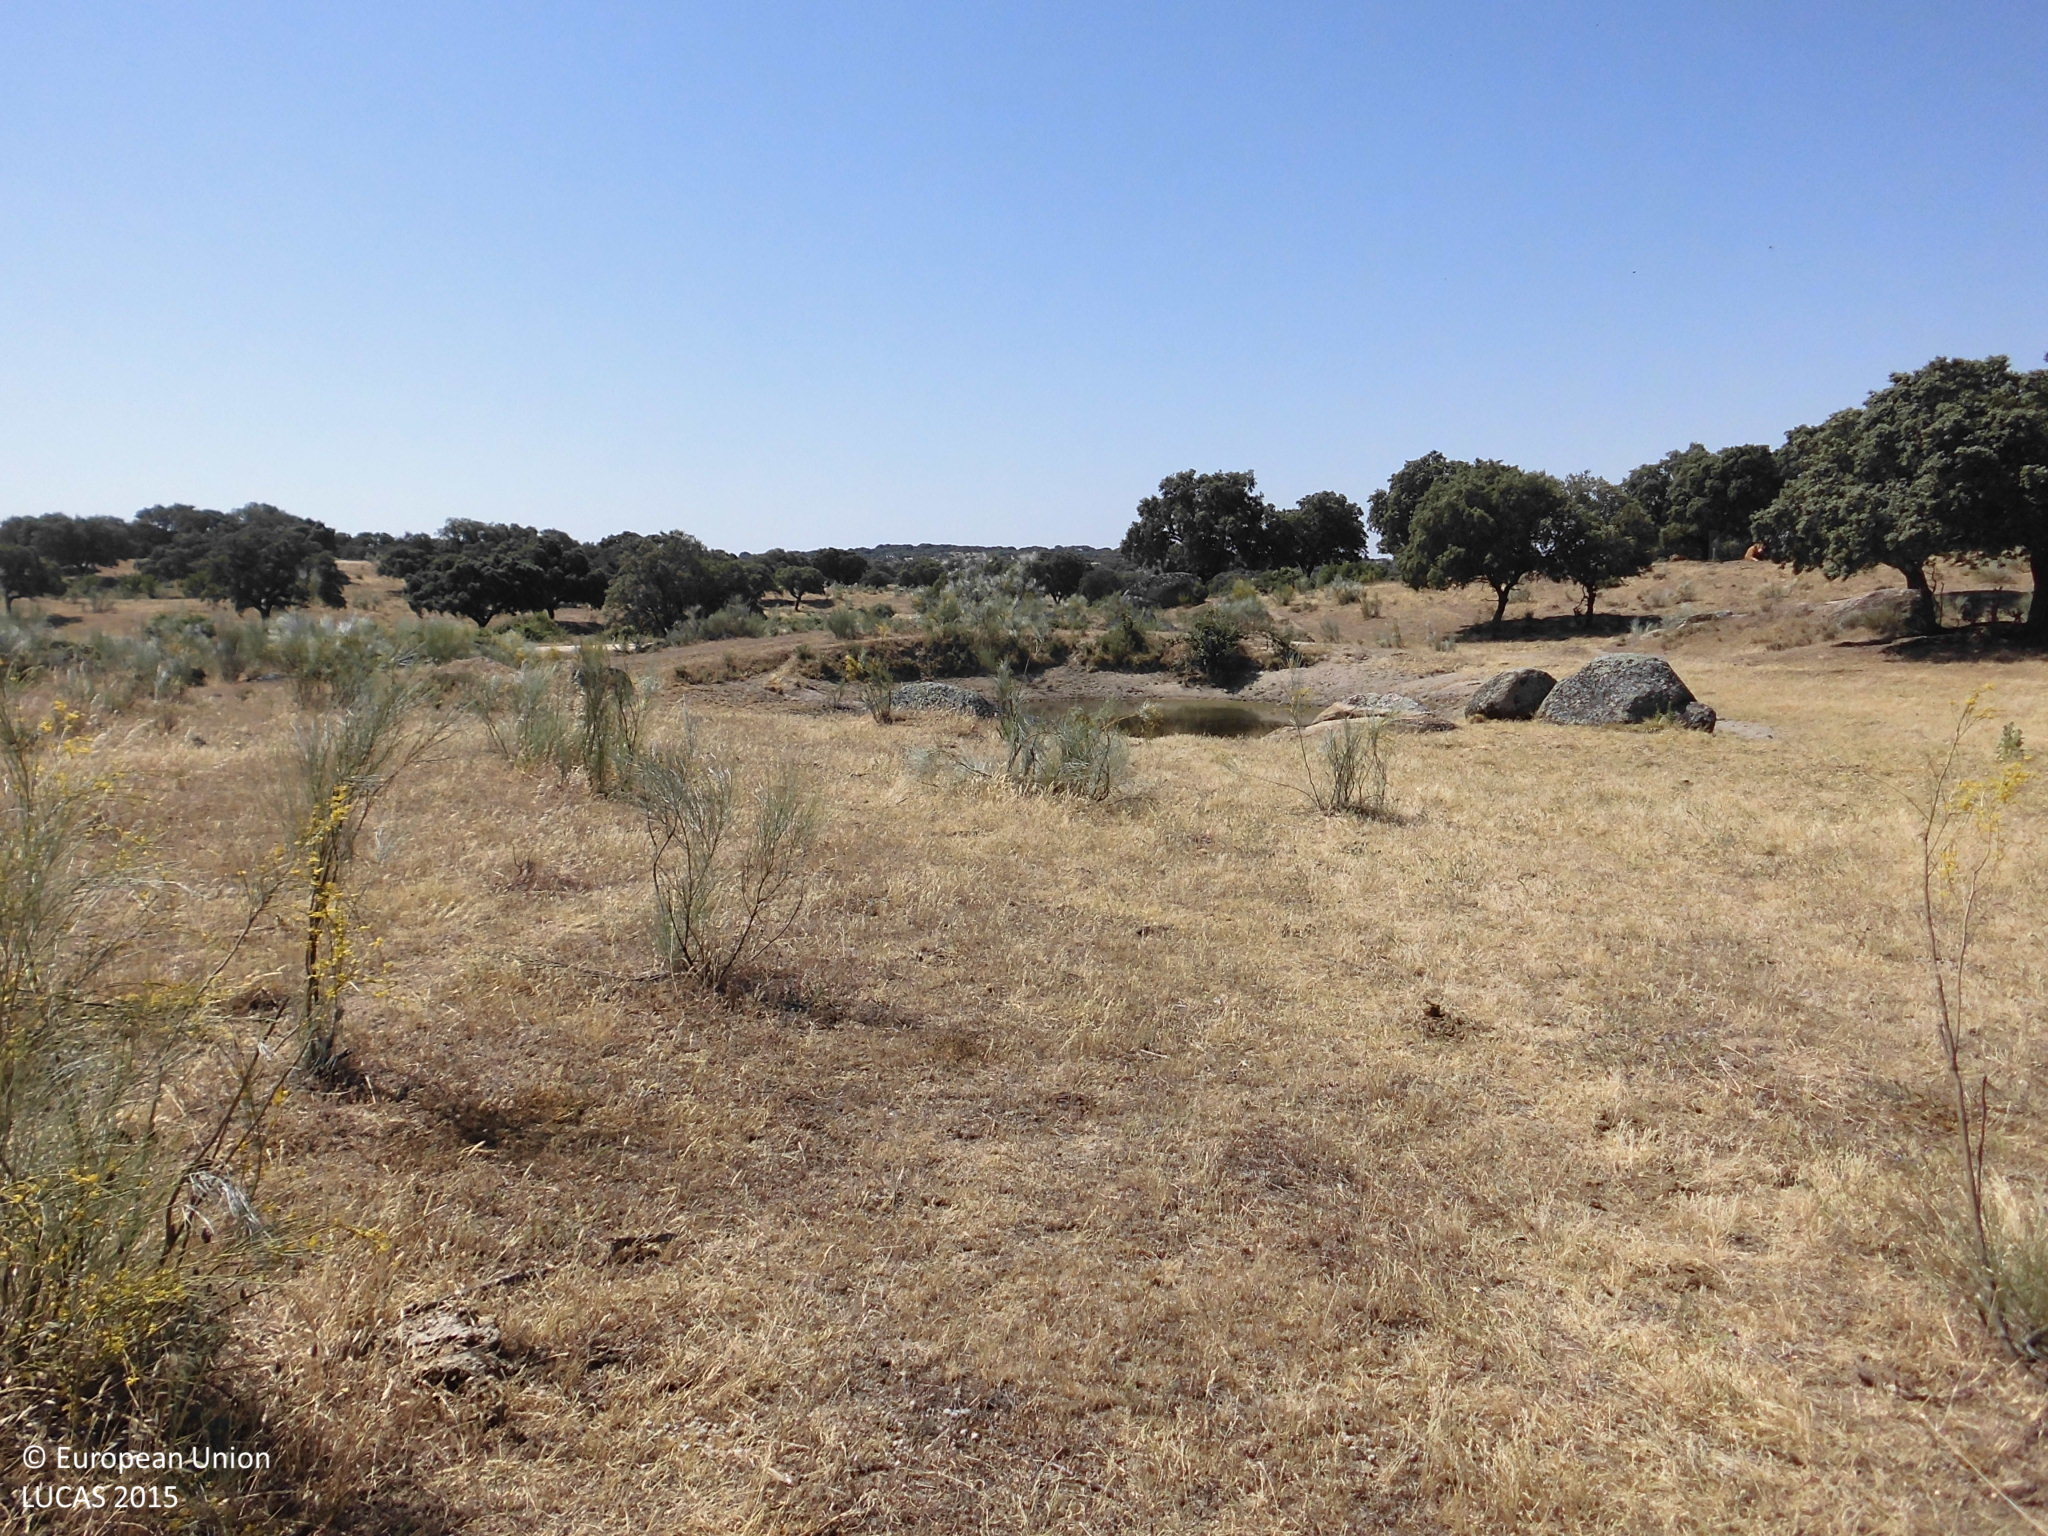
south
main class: Woodland
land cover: Broadleaved woodland
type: broadleaved evergreen forest
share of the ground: 10 - 25 %
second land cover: Grassland without tree/shrub cover
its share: > 75 %
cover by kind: herbaceous plants 85 %, broadleaved forest trees 15 %
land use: Forestry
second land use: Agriculture (excluding fallow land and kitchen gardens)
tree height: > 5 m
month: May
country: ES
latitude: 39.6876
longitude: -6.7181
